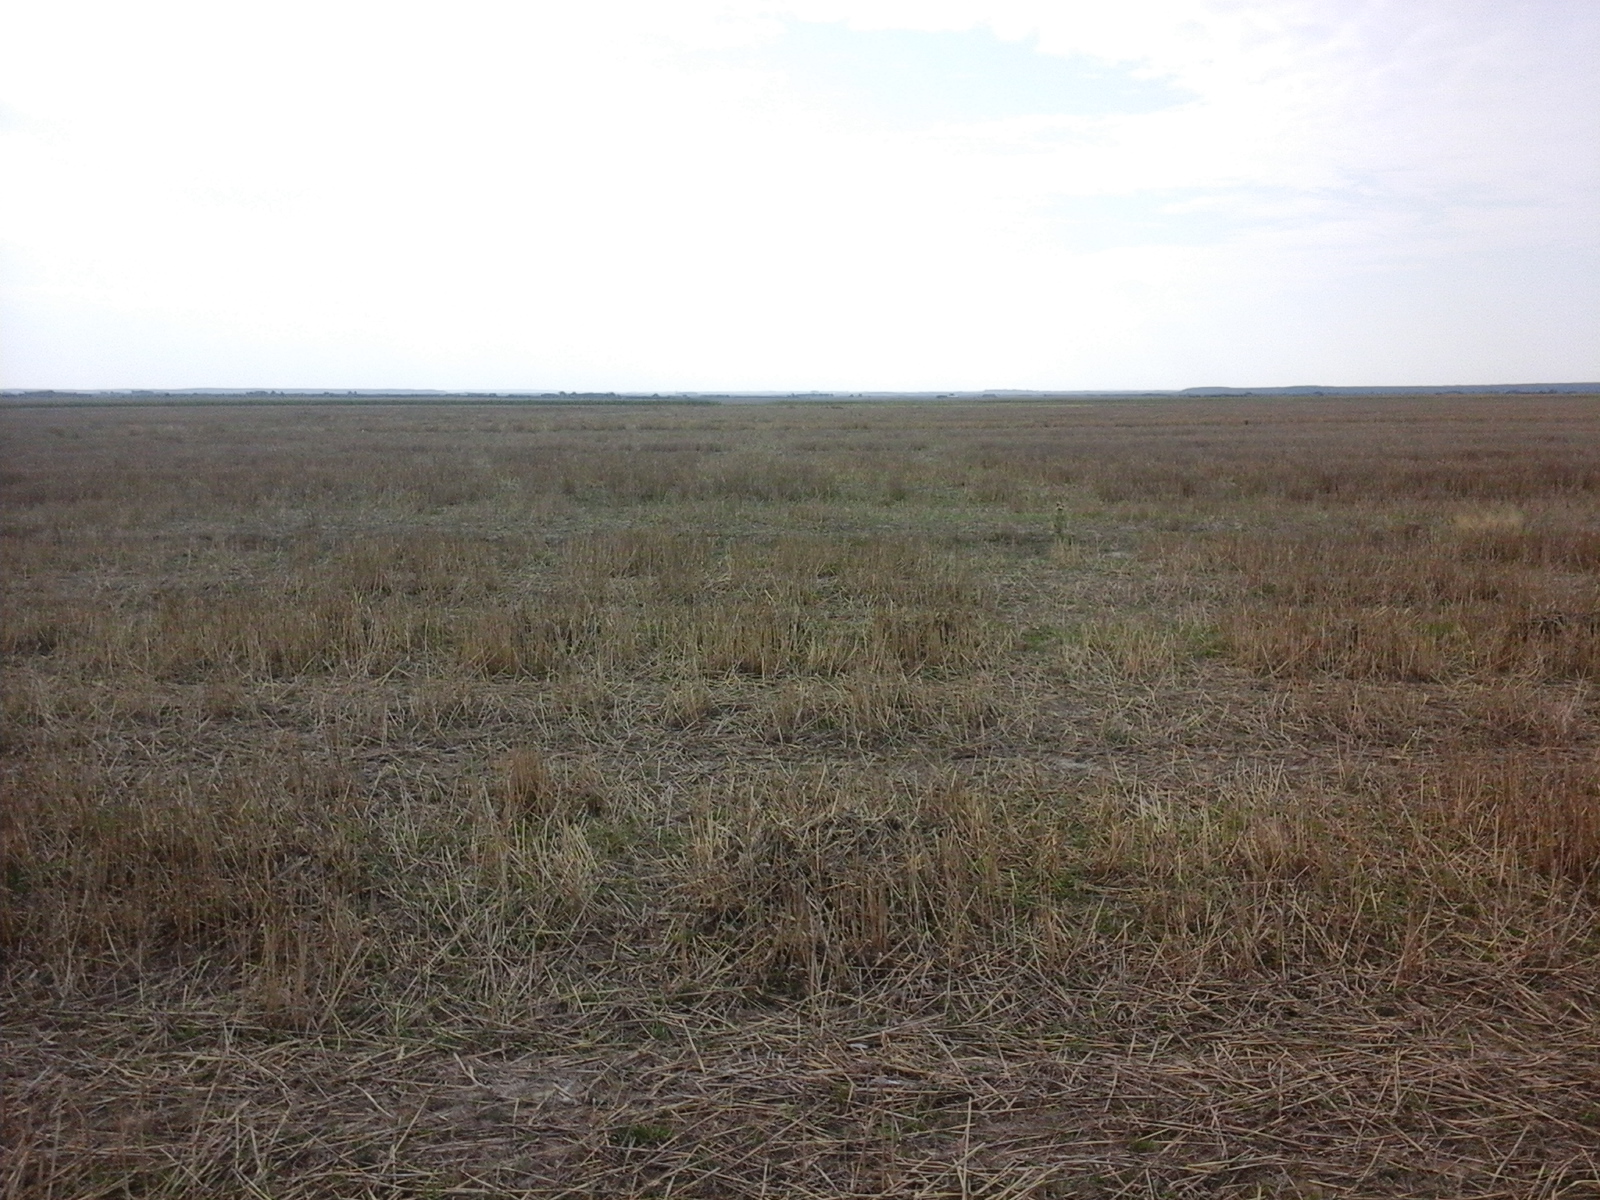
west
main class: Cropland
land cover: Common wheat
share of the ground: 25 - 50 %
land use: Agriculture (excluding fallow land and kitchen gardens)
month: August
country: RO
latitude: 46.6257
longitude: 21.9422
